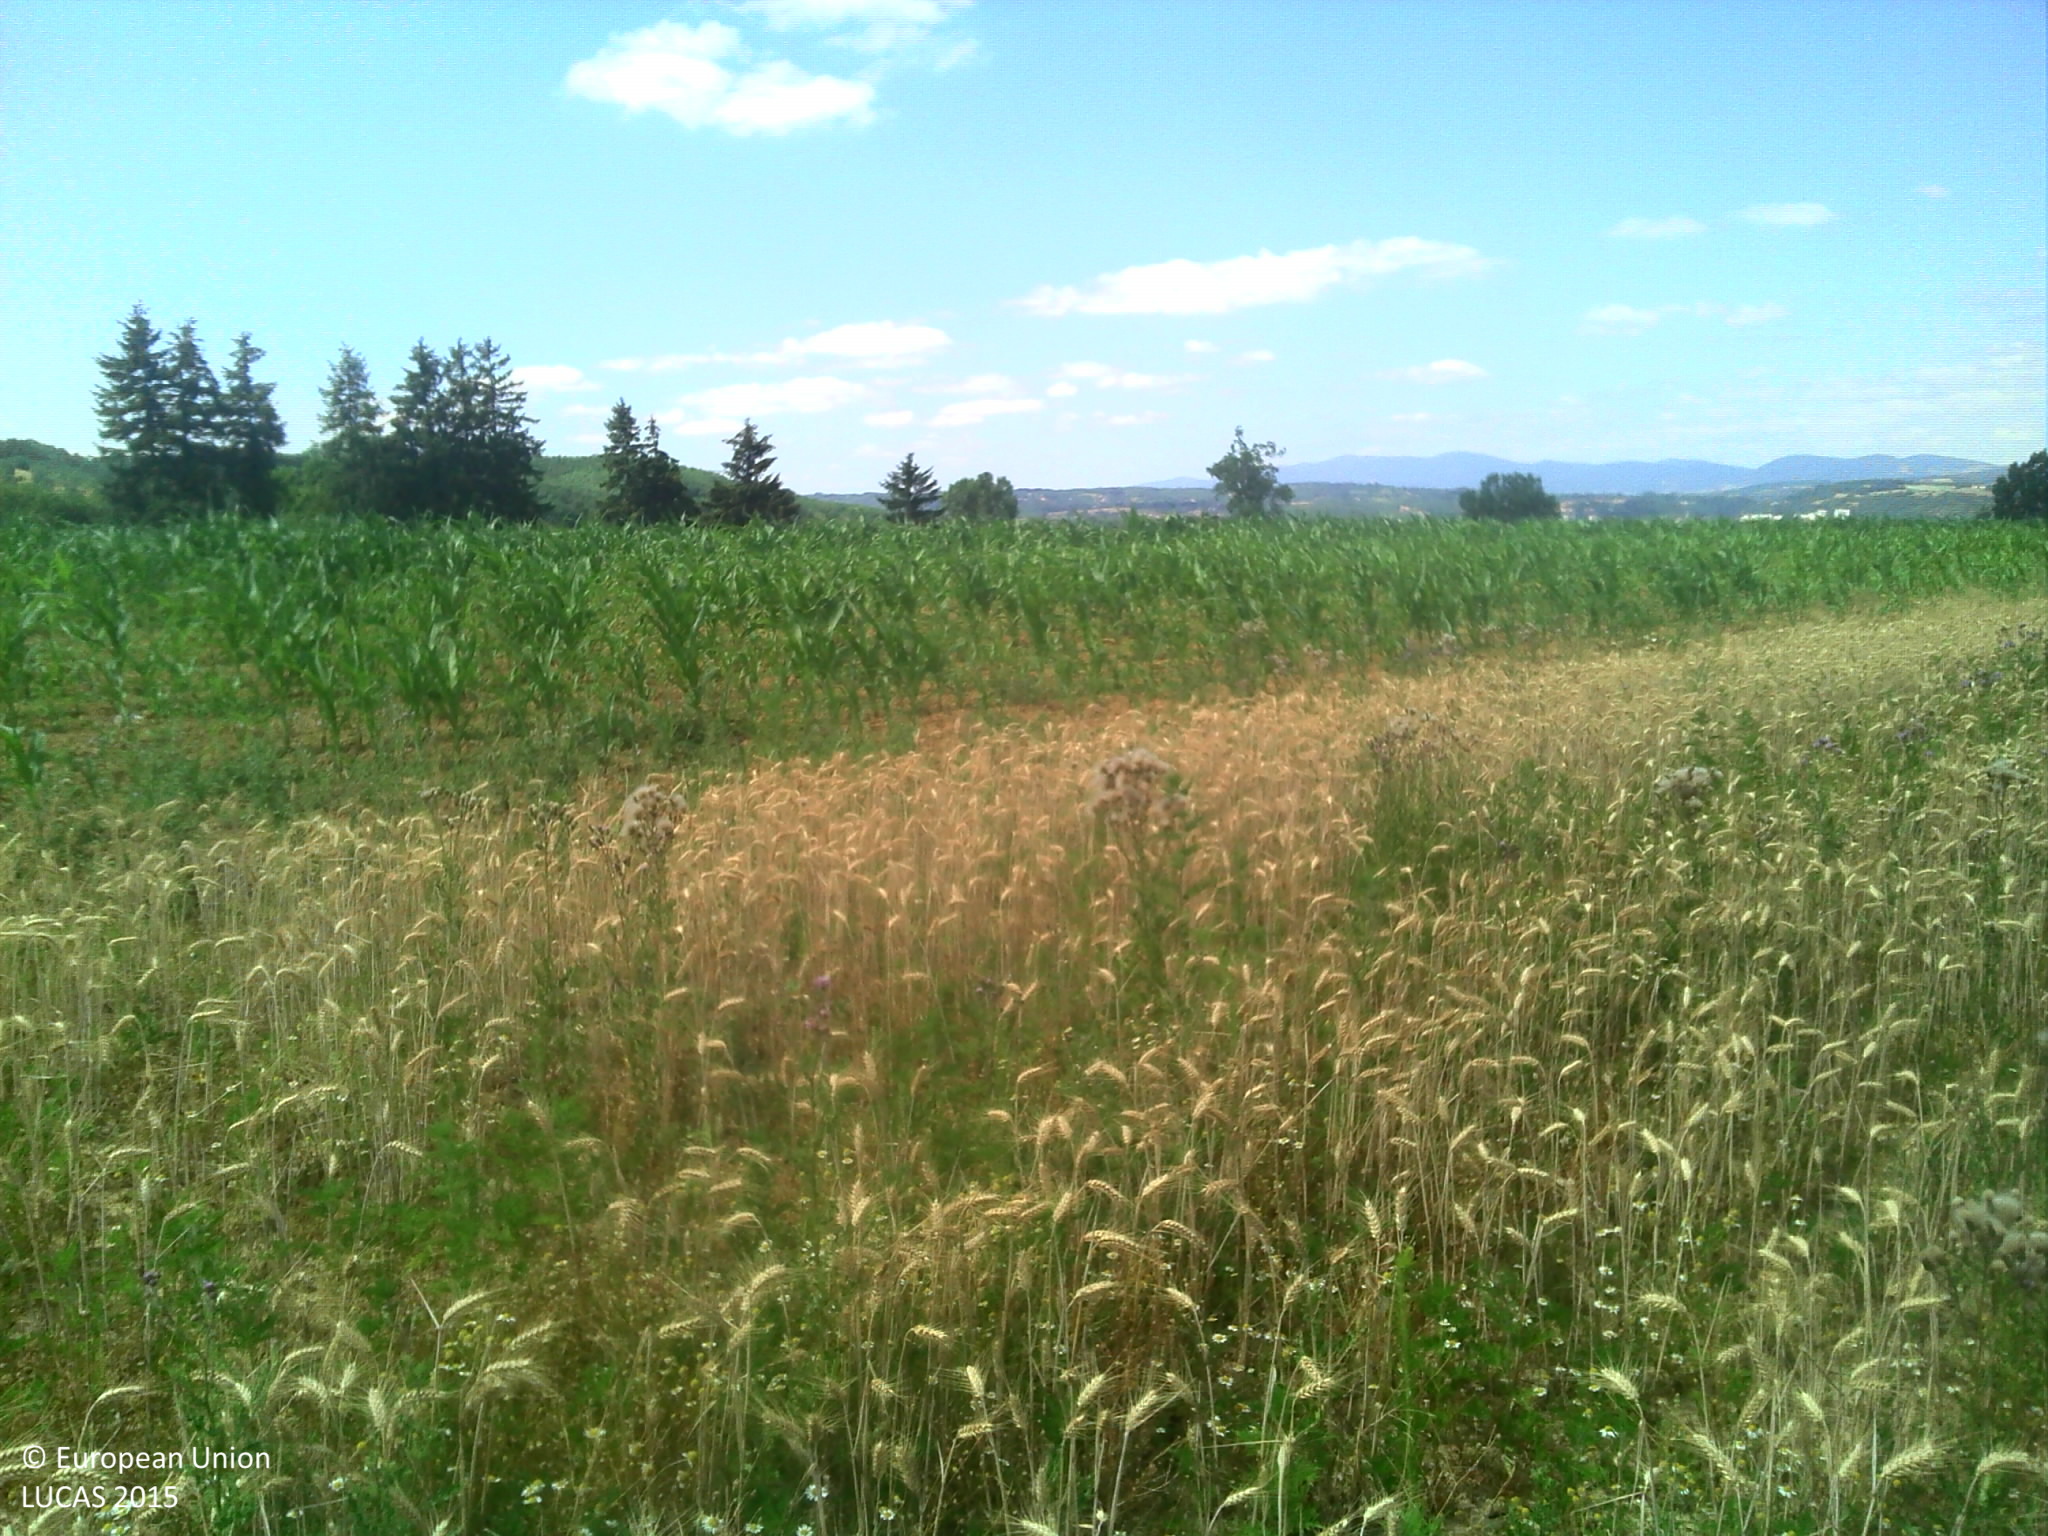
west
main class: Cropland
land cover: Durum wheat
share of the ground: > 75 %
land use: Agriculture (excluding fallow land and kitchen gardens)
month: July
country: FR
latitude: 45.5470
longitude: 4.9705
